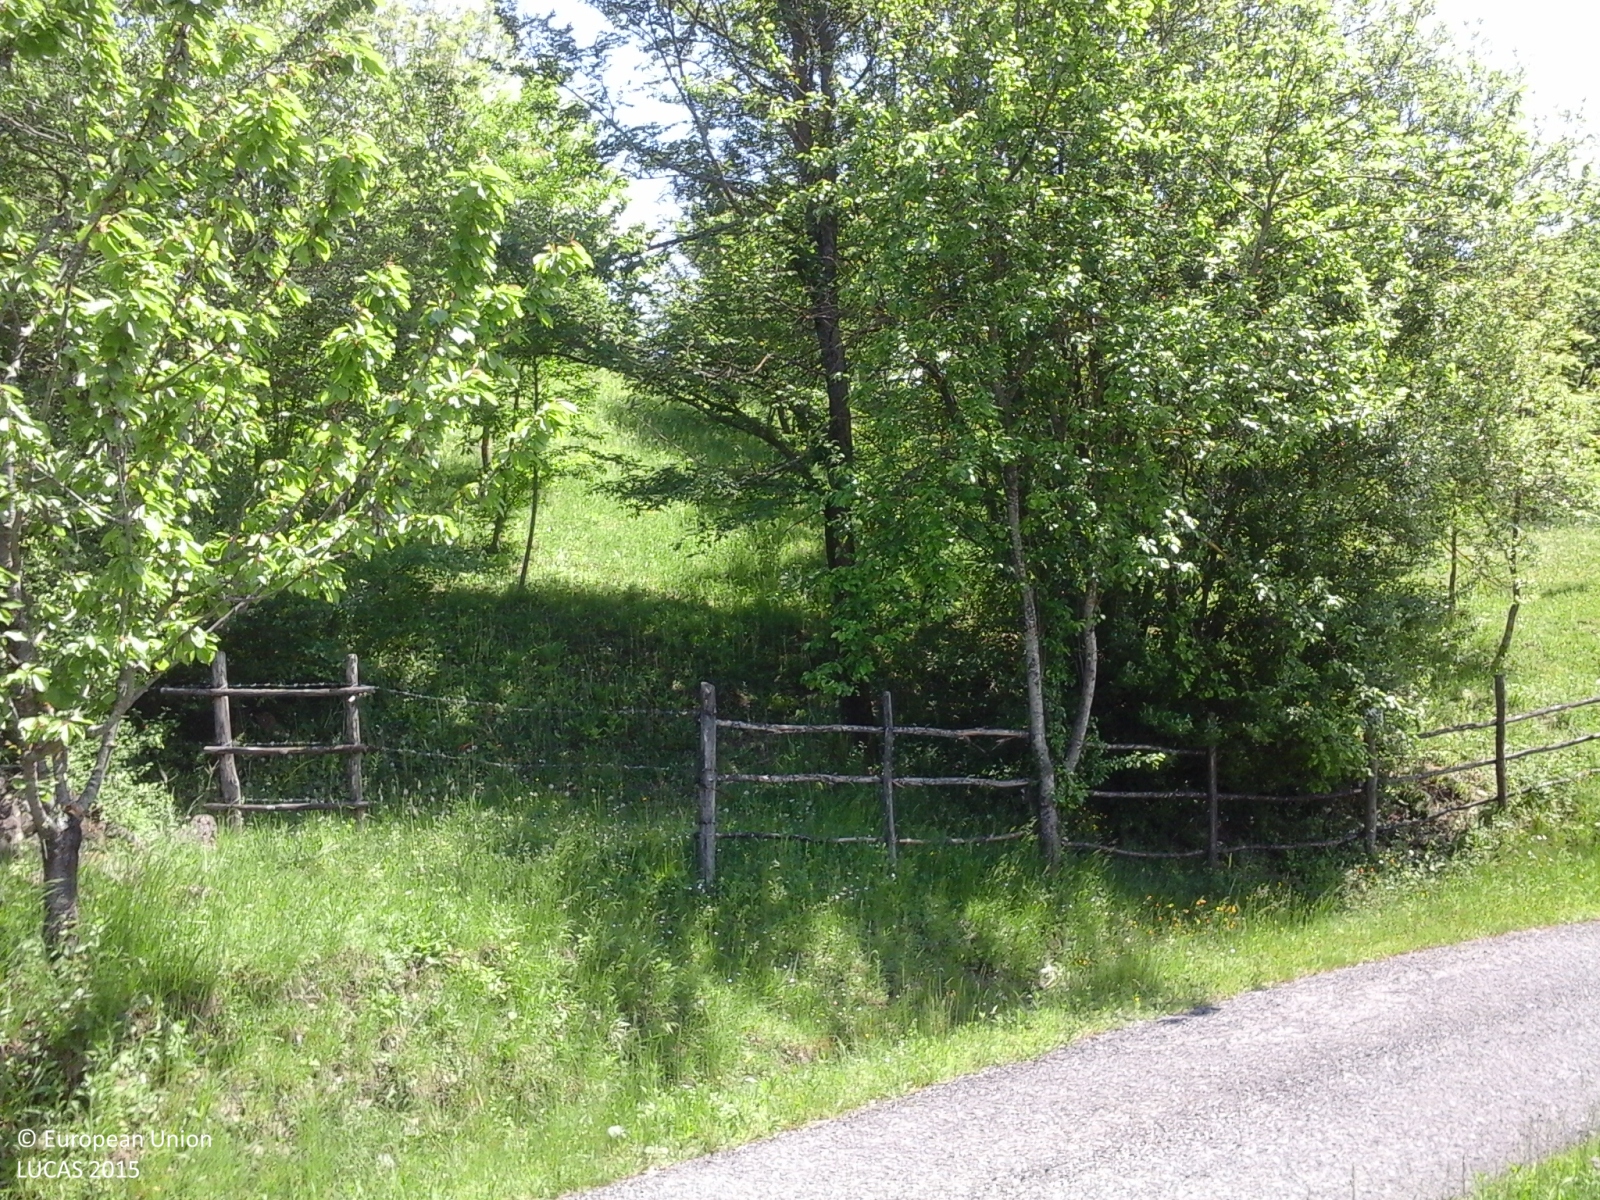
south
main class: Grassland
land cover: Grassland with sparse tree/shrub cover
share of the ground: > 75 %
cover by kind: herbaceous plants 90 %, broadleaved forest trees 5 %, shrubs 5 %
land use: Agriculture (excluding fallow land and kitchen gardens)
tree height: > 5 m
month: May
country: IT
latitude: 44.7646
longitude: 9.6092
